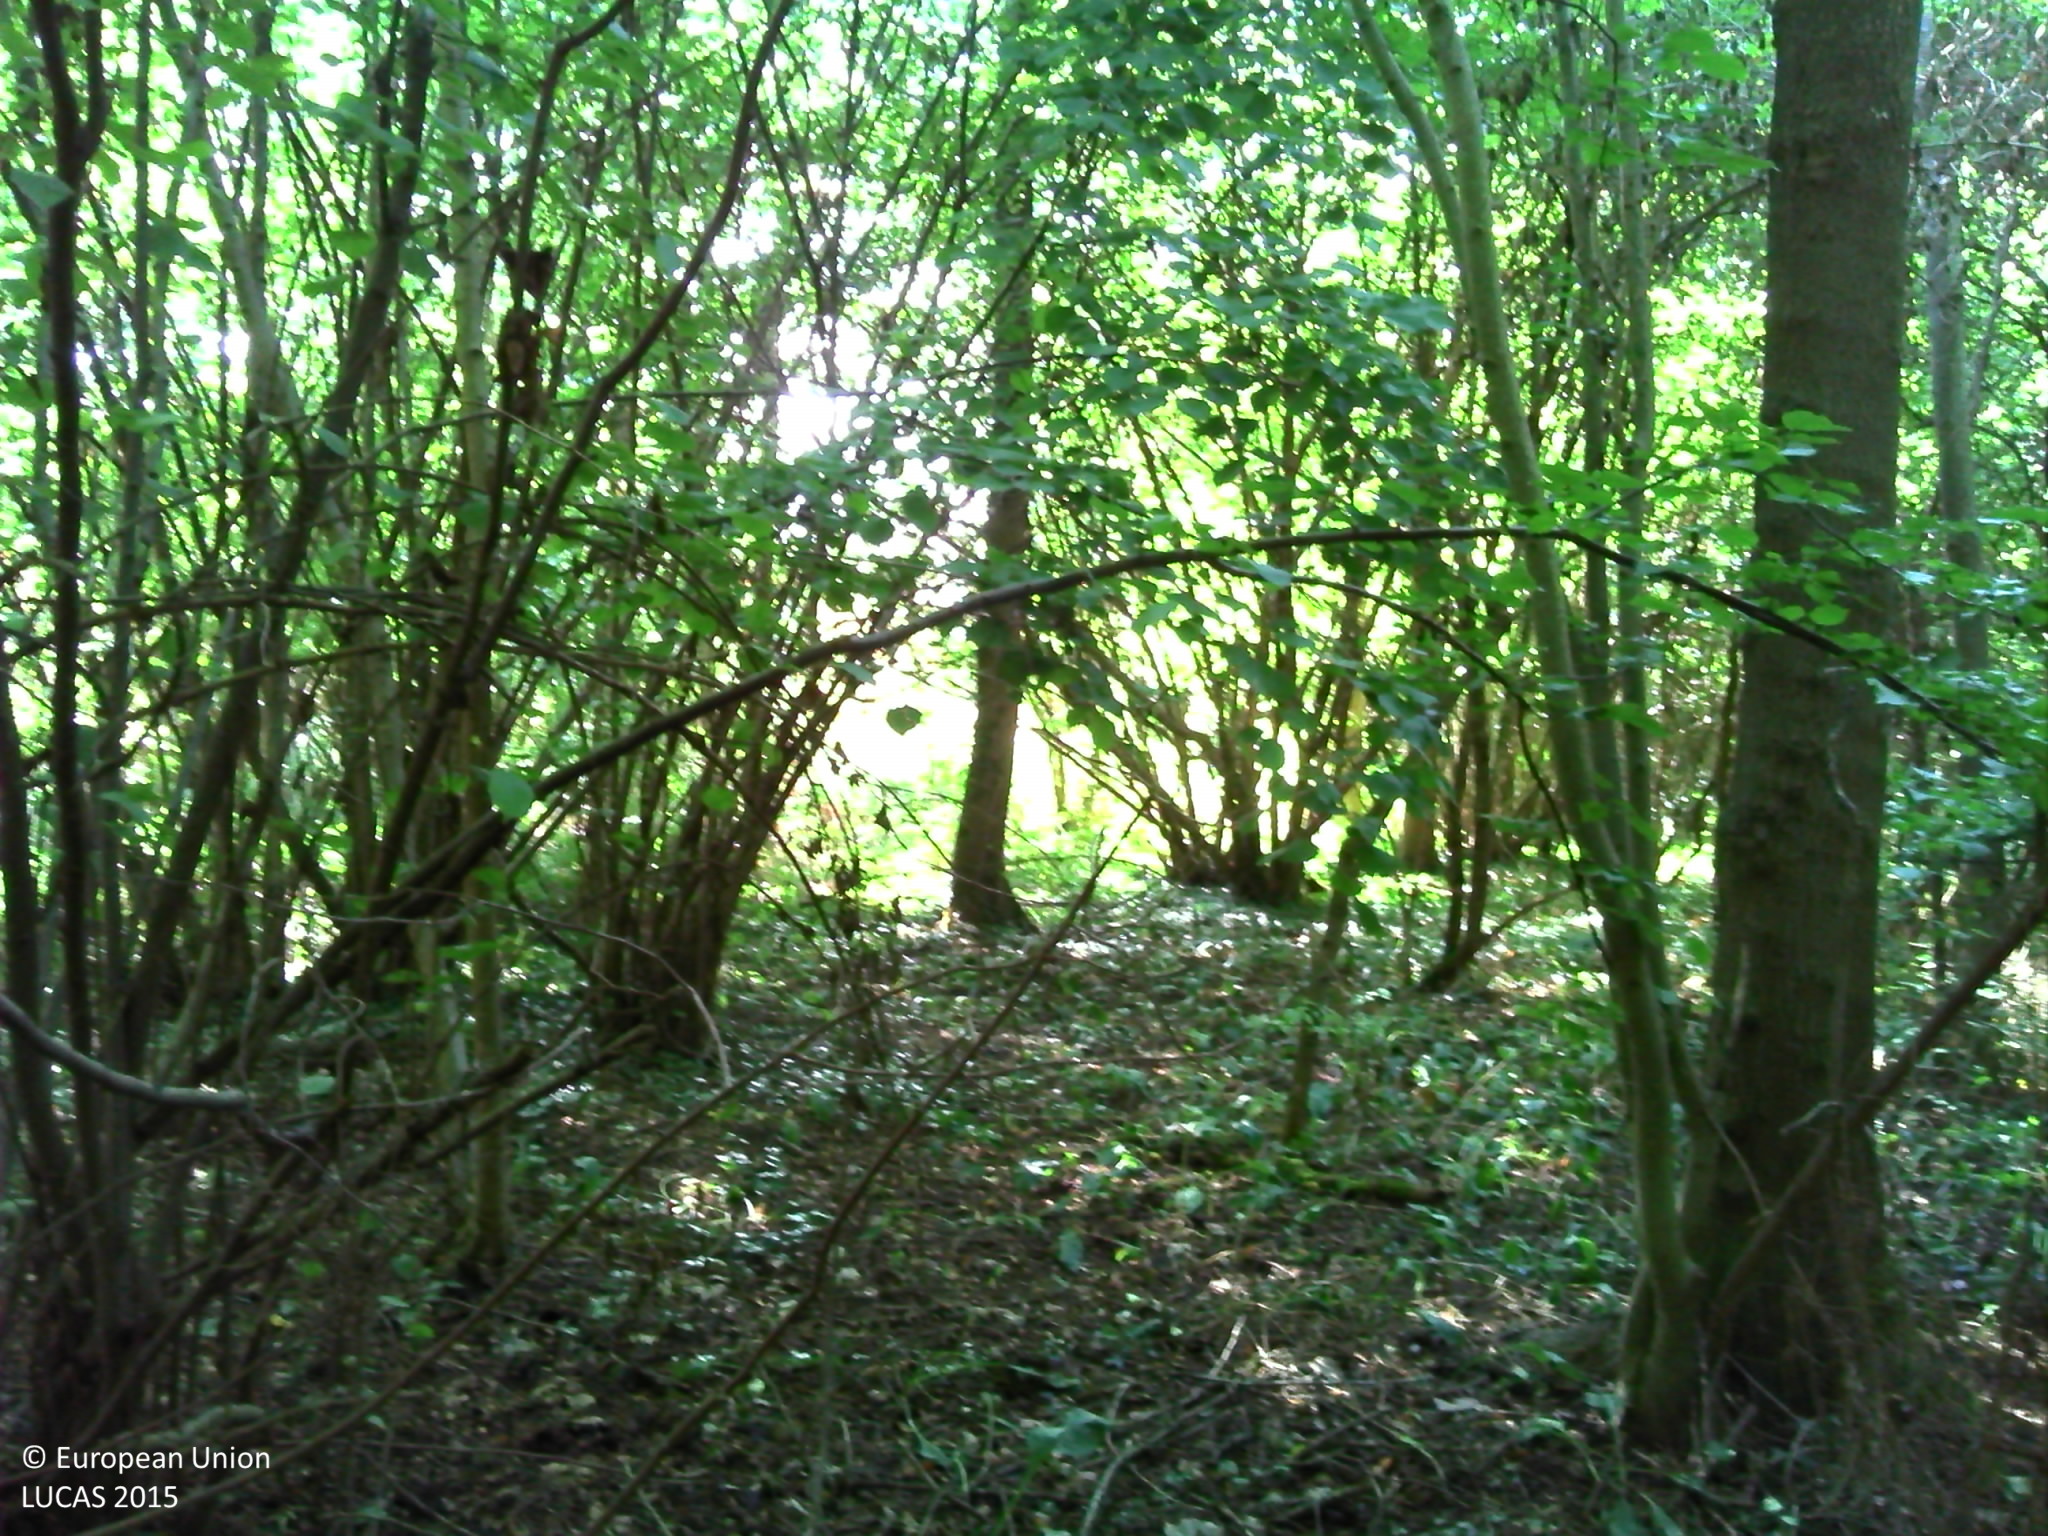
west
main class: Woodland
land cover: Broadleaved woodland
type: acidophilous oak and oak-birch forest
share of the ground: > 75 %
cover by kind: broadleaved forest trees 60 %, herbaceous plants 15 %, unconsolidated bare surface 15 %, lichens and mosses 10 %
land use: Semi-natural and natural areas not in use
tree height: > 5 m
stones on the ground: 25 - 50 %
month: July
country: FR
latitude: 45.7176
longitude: 4.0799
